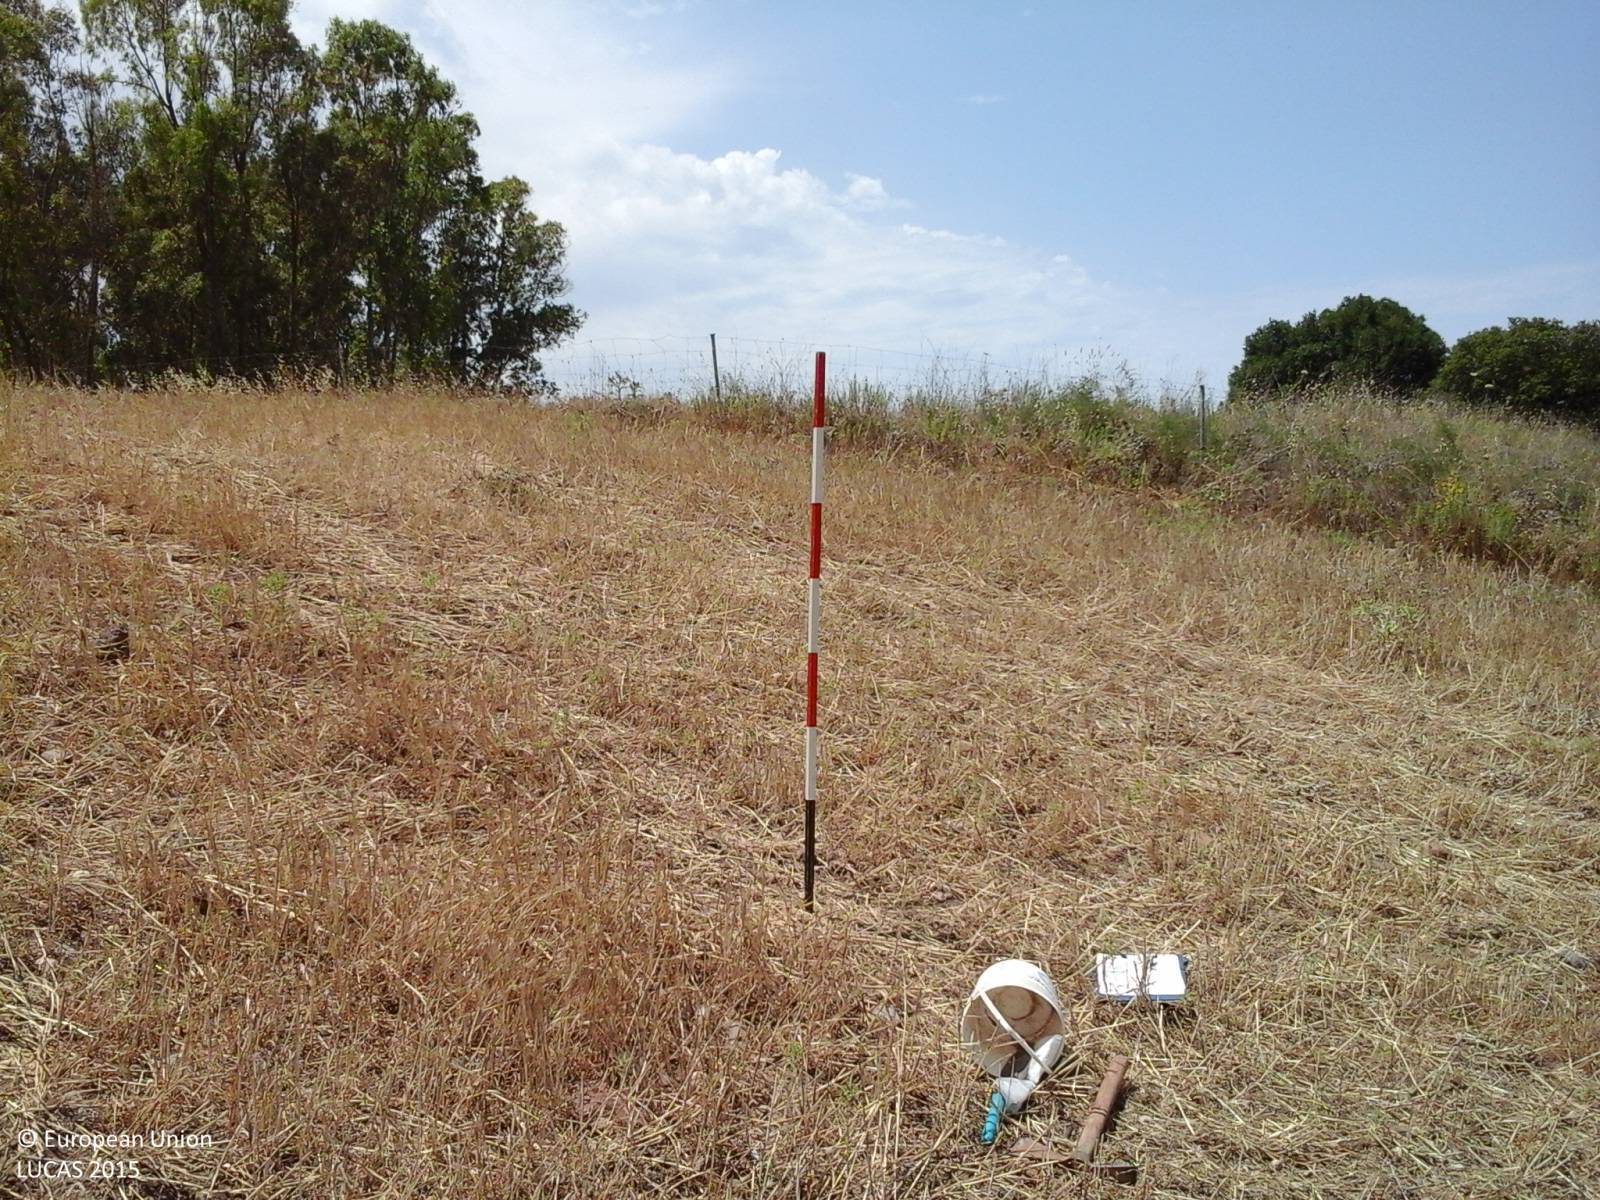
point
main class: Cropland
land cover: Barley
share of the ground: > 75 %
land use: Agriculture (excluding fallow land and kitchen gardens)
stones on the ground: 25 - 50 %
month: June
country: IT
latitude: 39.8786
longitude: 8.7093
